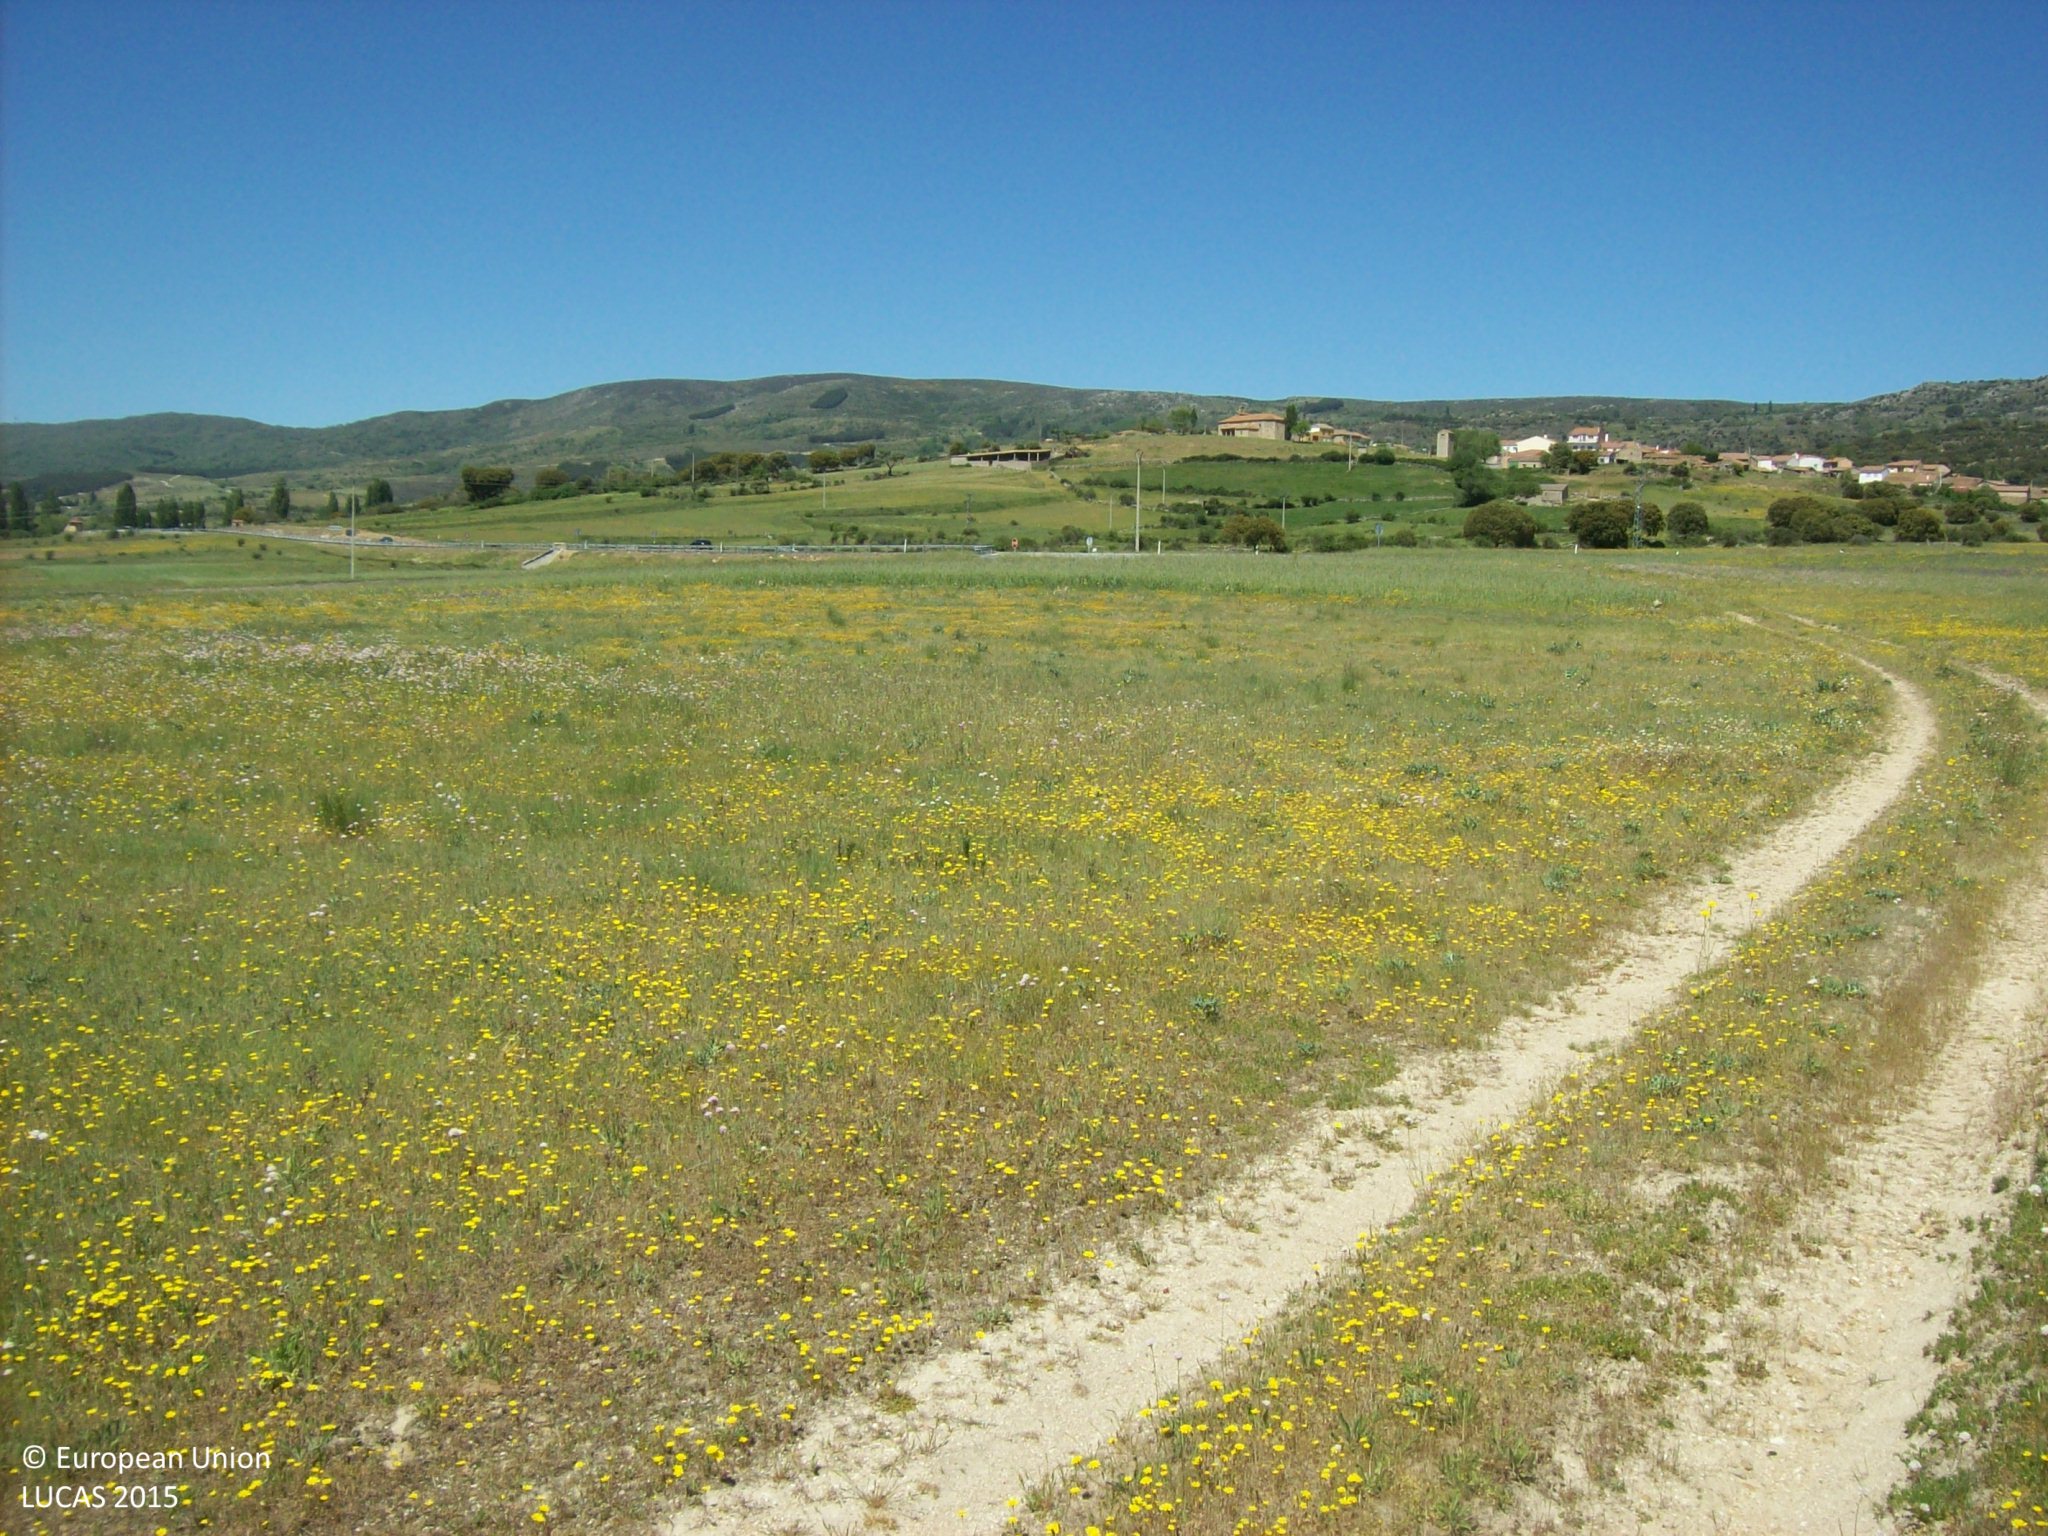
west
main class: Grassland
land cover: Grassland without tree/shrub cover
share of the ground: > 75 %
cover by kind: herbaceous plants 90 %
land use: Abandoned areas
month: May
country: ES
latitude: 40.5645
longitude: -5.0725
